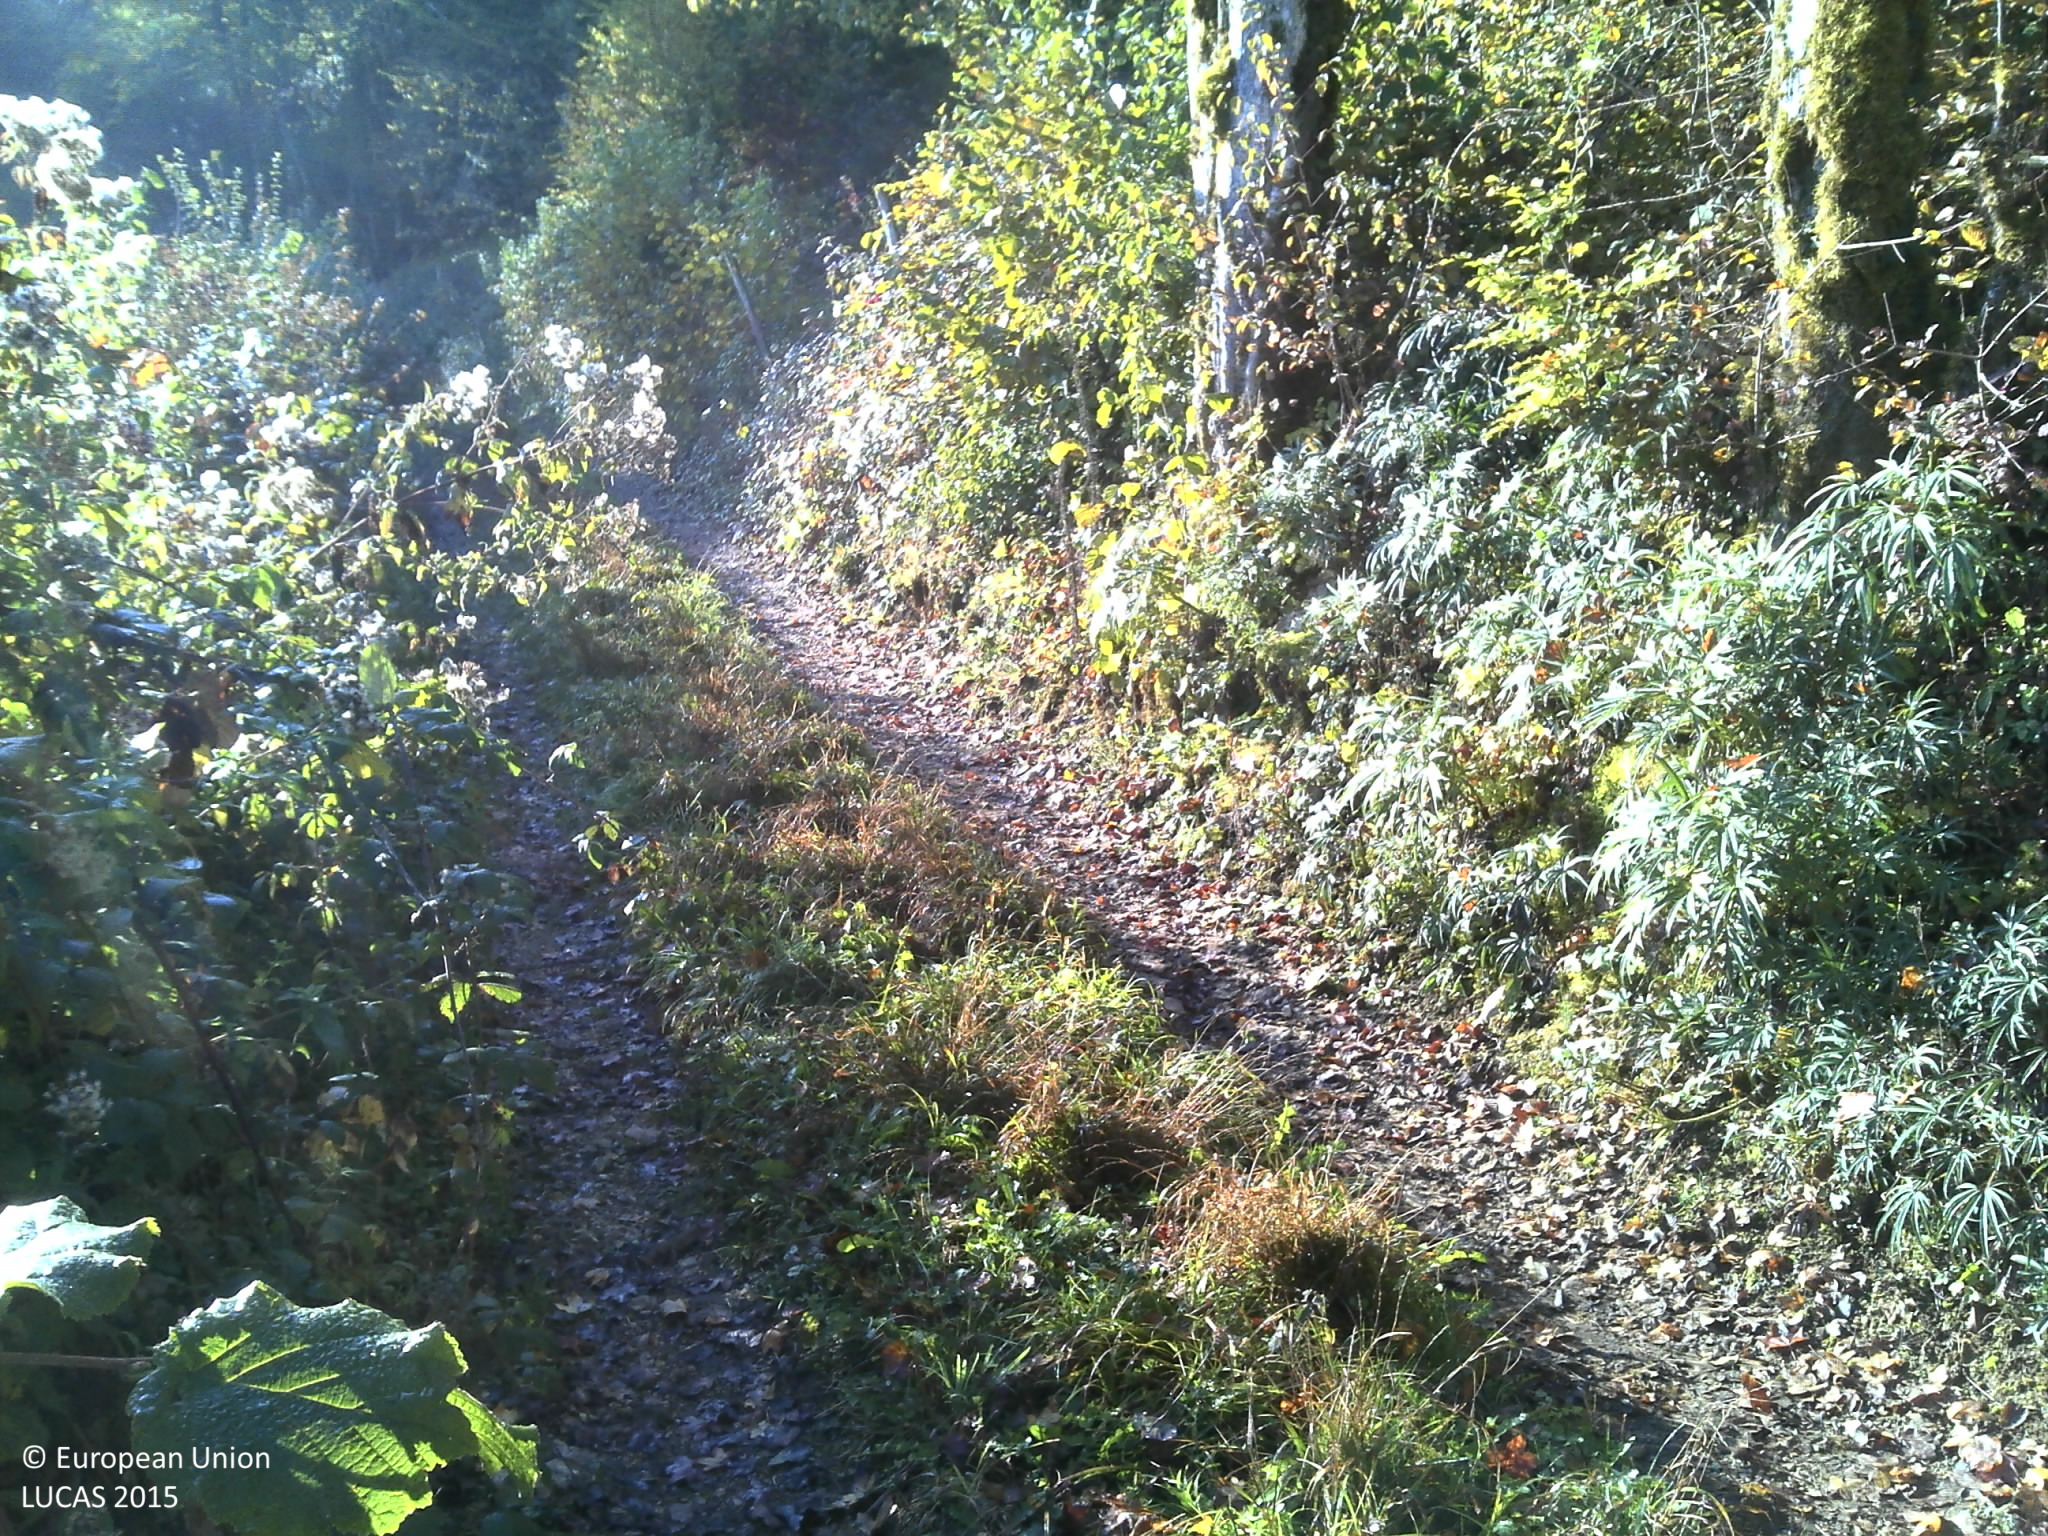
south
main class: Shrubland
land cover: Shrubland with sparse tree cover
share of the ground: > 75 %
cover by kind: shrubs 95 %, broadleaved forest trees 5 %
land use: Semi-natural and natural areas not in use
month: October
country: FR
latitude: 45.9286
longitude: 5.4257
